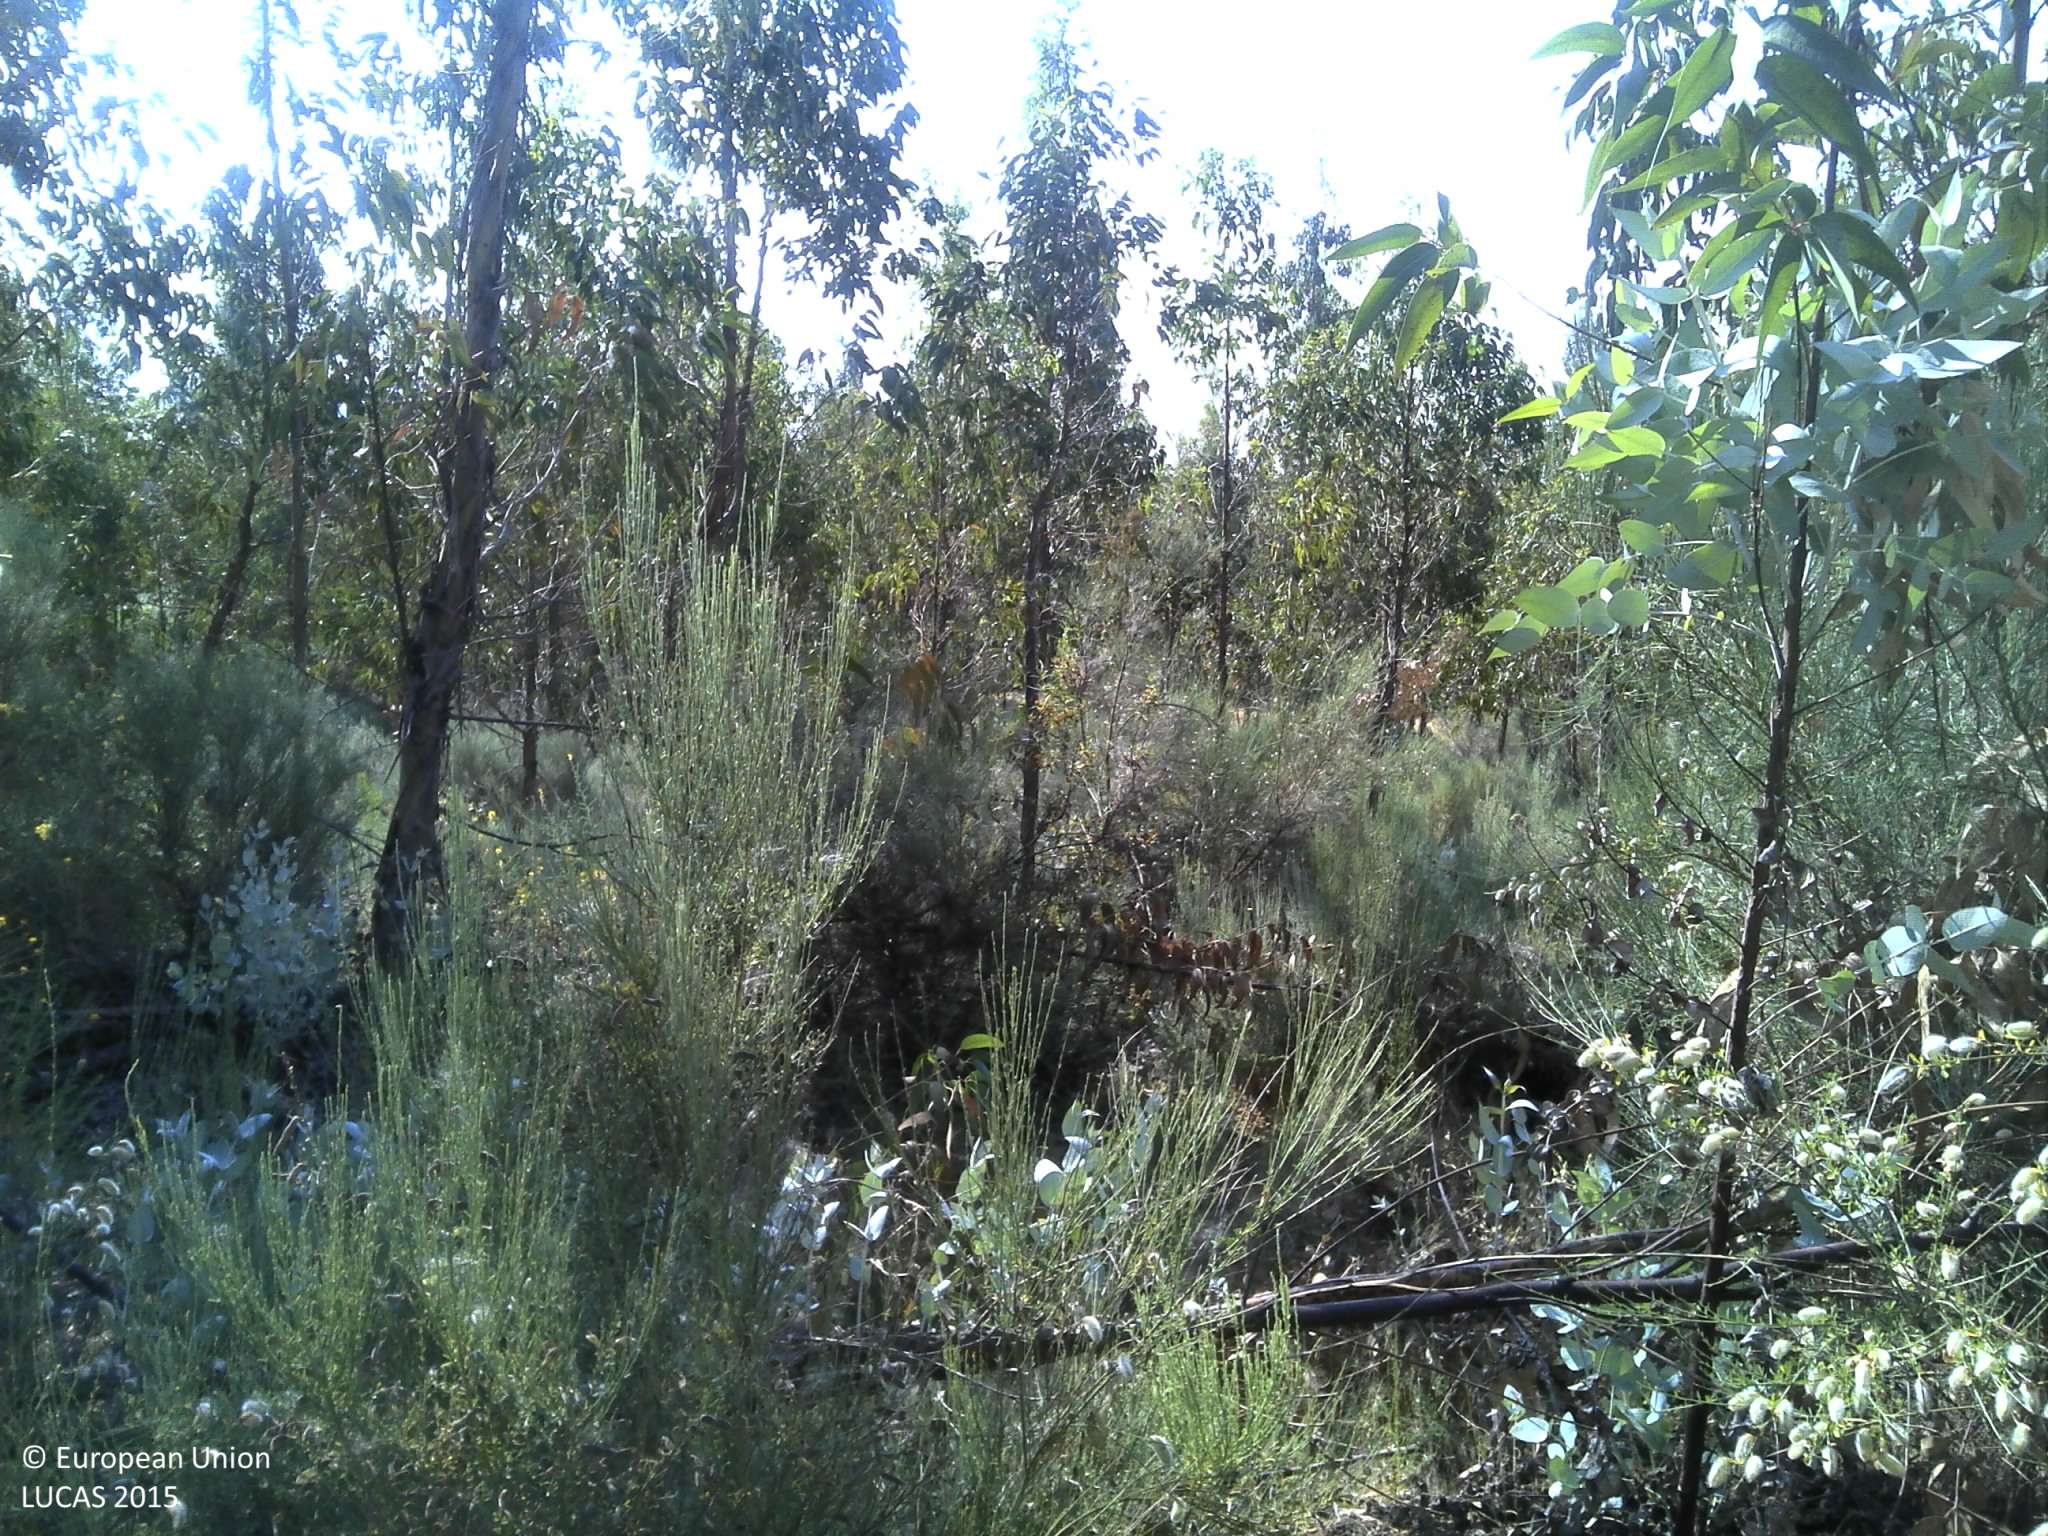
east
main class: Woodland
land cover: Broadleaved woodland
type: exotic forest
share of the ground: 25 - 50 %
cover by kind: broadleaved forest trees 50 %, unconsolidated bare surface 30 %, shrubs 20 %
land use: Forestry
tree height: > 5 m
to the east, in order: Broadleaved woodland; Tracks; Broadleaved woodland; Tracks; Grass margins; Ditches and canals; Grass margins; Cherry fruit; Grass margins; Ditches and canals; Grass margins; Apple fruit
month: June
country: PT
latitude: 40.2268
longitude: -7.3189
